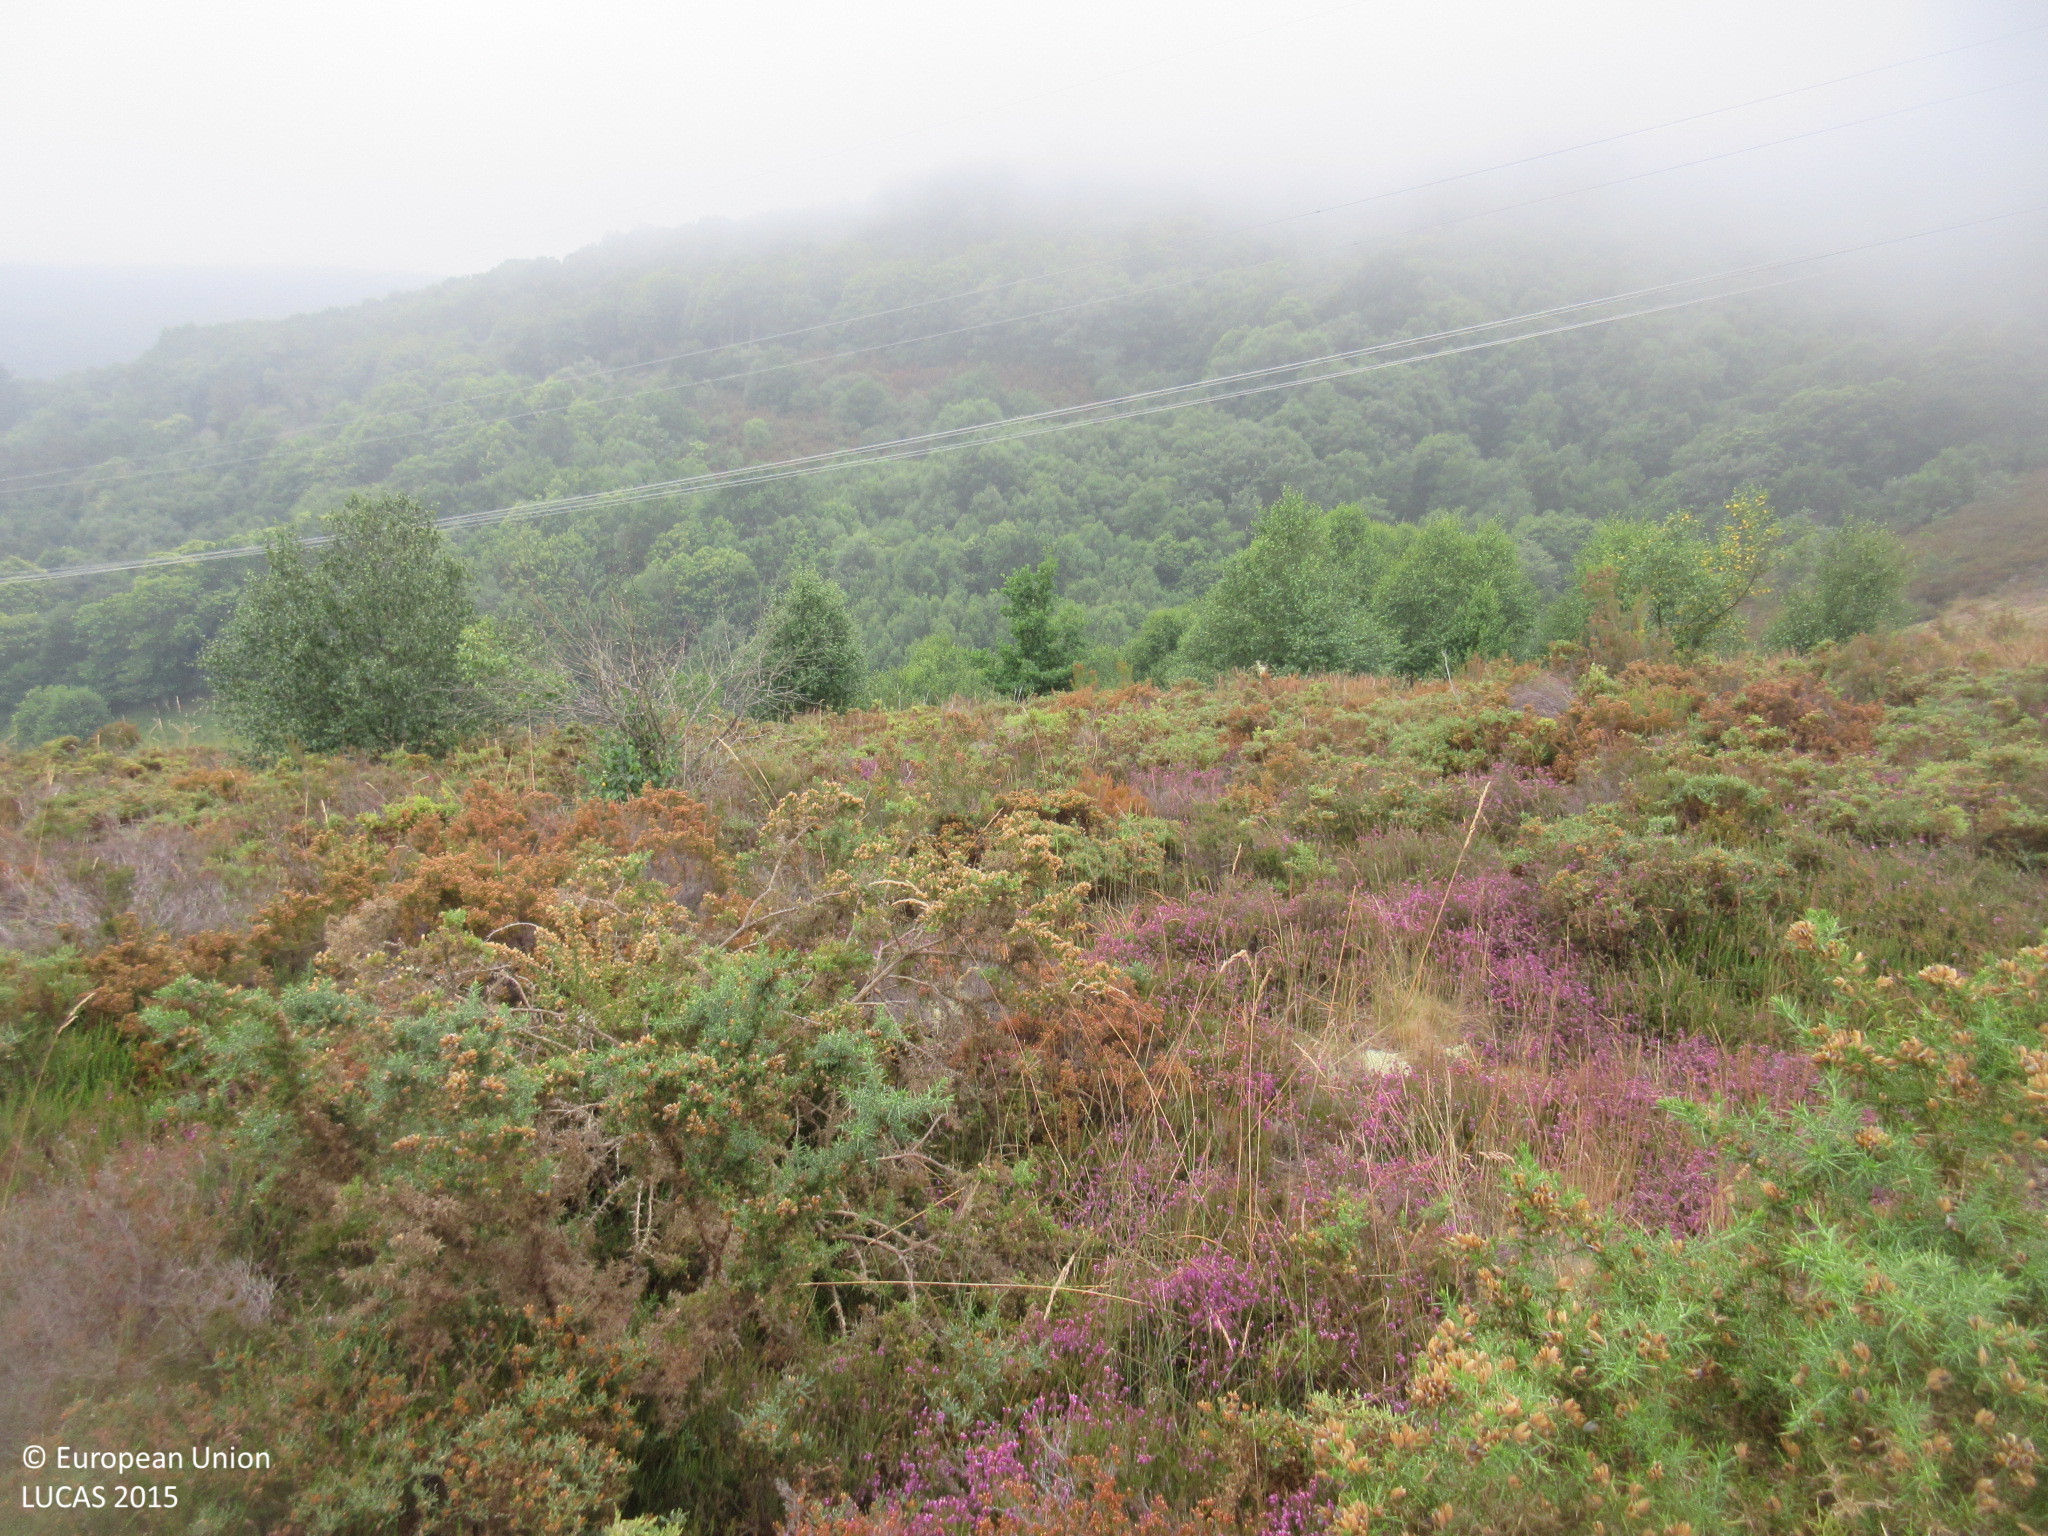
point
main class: Shrubland
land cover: Shrubland with sparse tree cover
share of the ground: > 75 %
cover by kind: shrubs 95 %, broadleaved forest trees 5 %
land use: Semi-natural and natural areas not in use
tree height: > 5 m
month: June
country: ES
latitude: 42.8959
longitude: -7.1228
